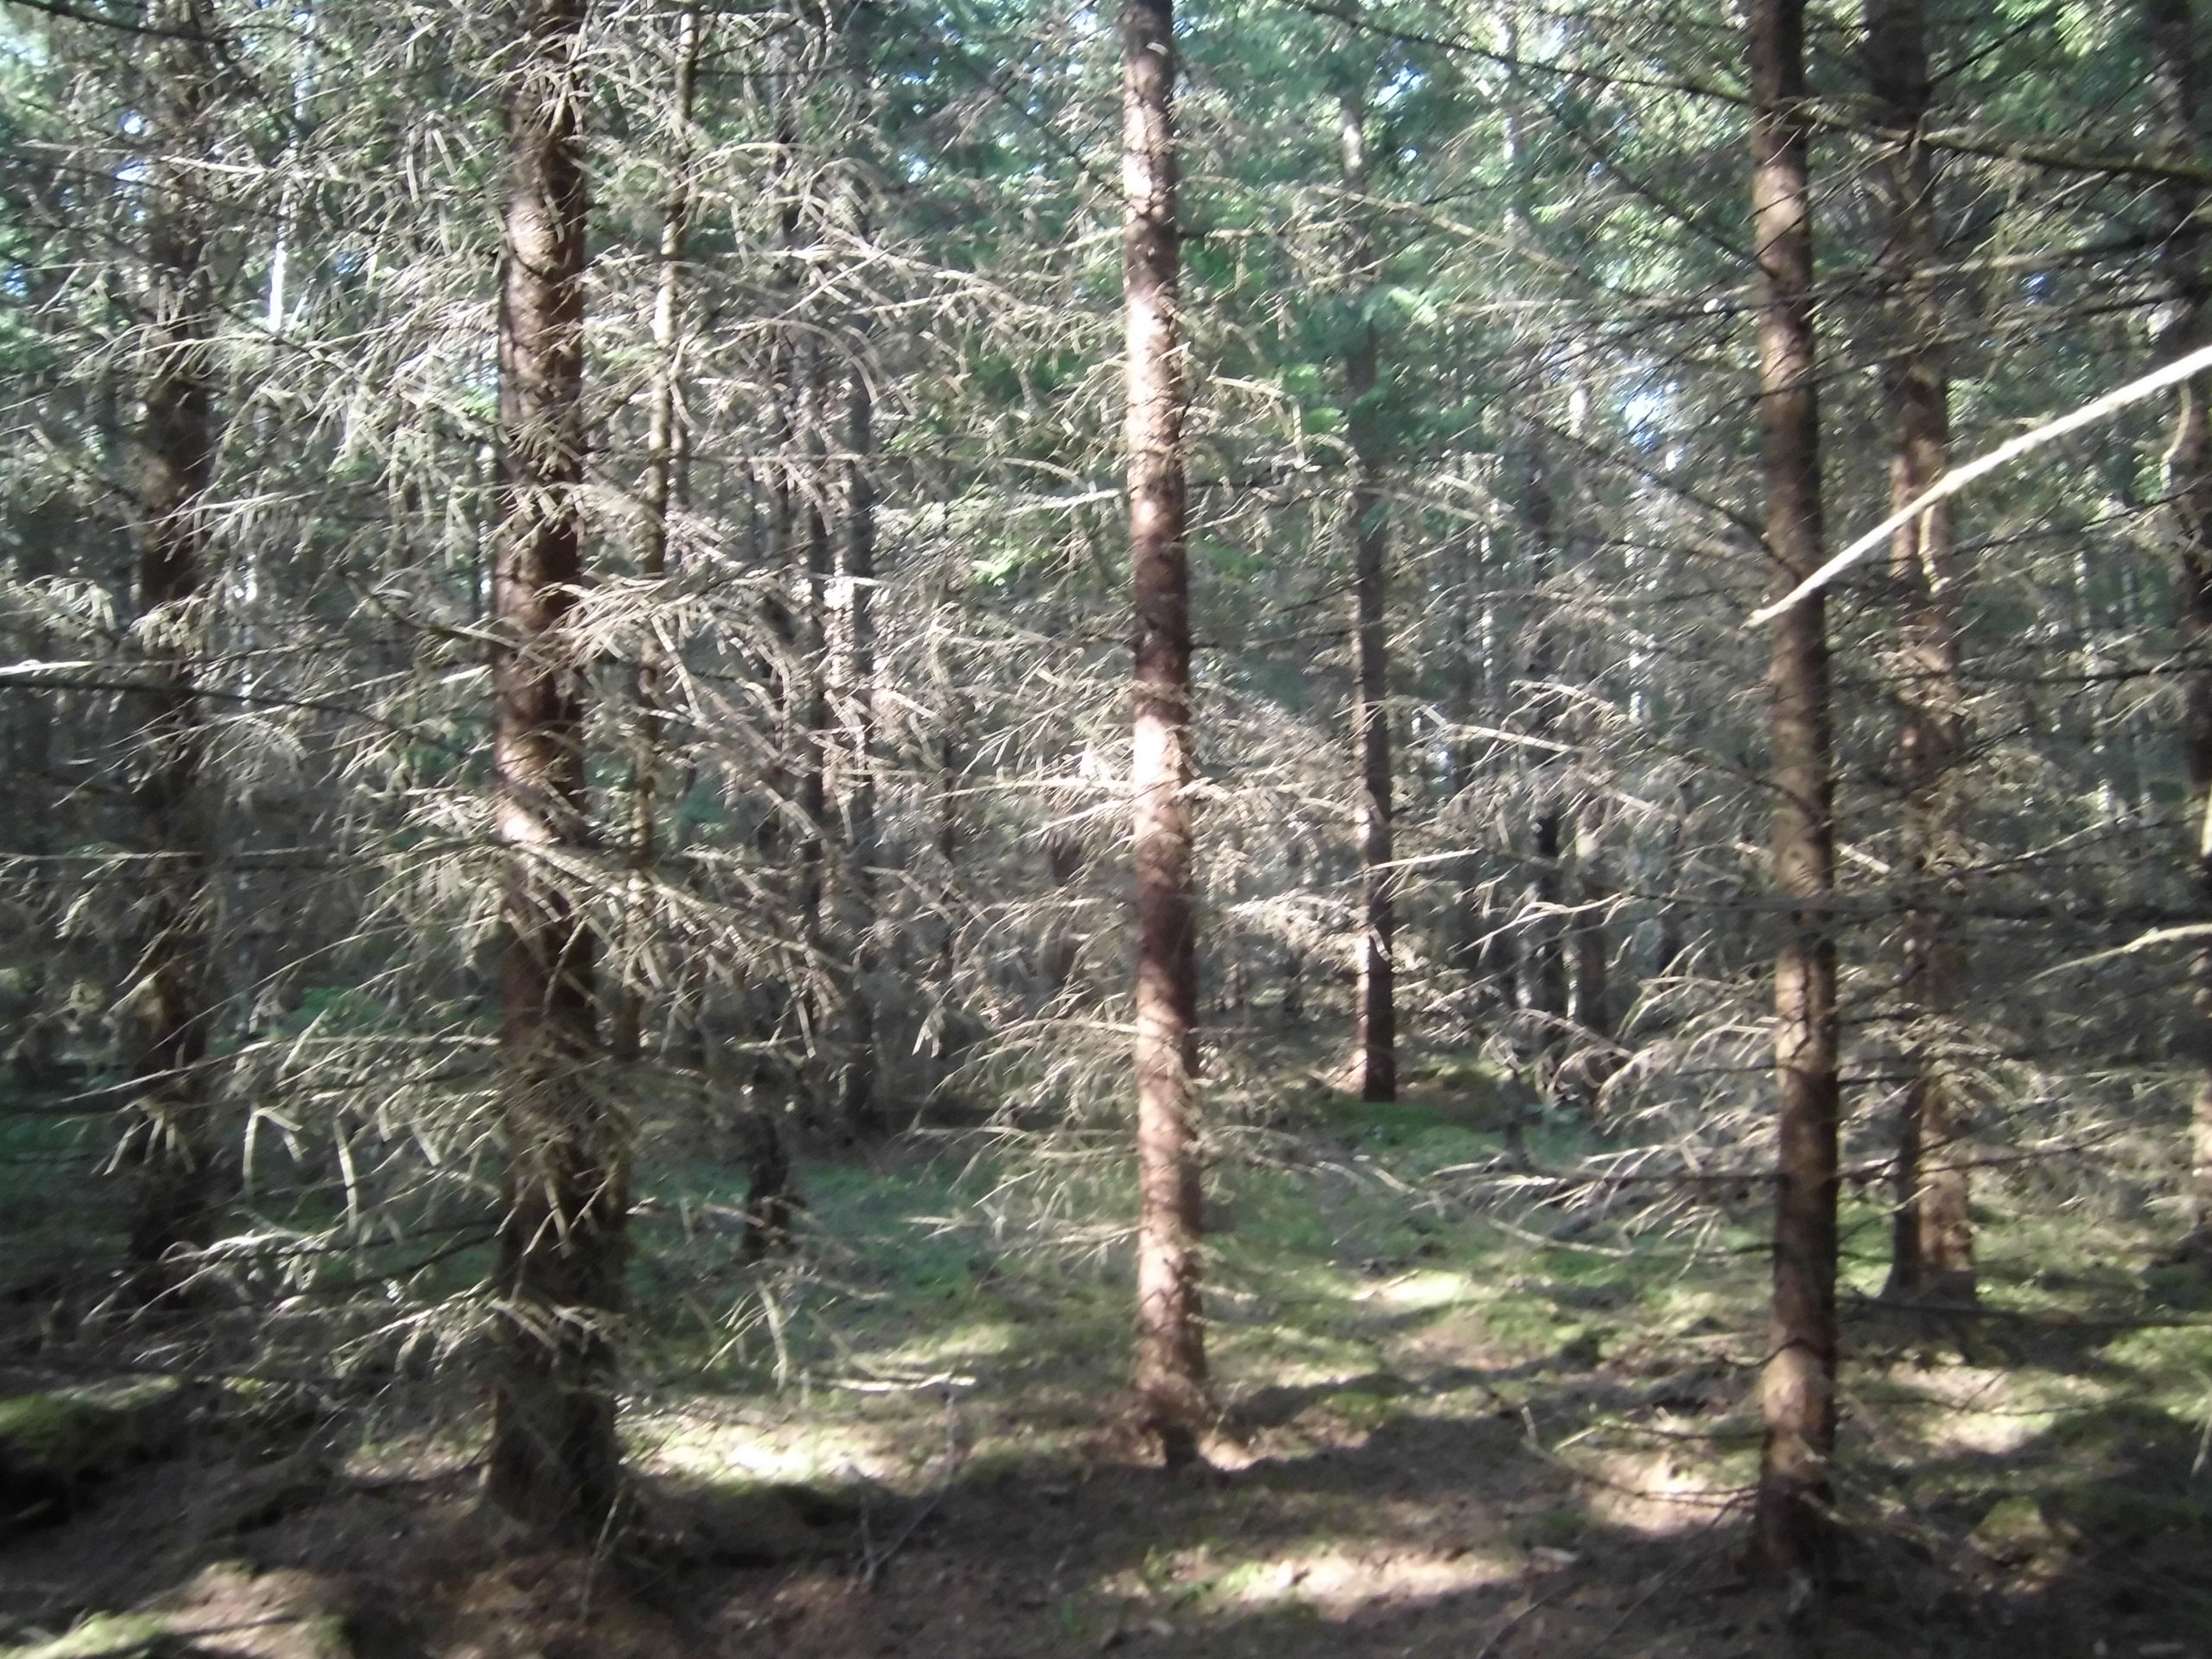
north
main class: Woodland
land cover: Spruce dominated coniferous woodland
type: boreal forest
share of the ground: > 75 %
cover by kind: coniferous forest trees 75 %, unconsolidated bare surface 15 %, herbaceous plants 5 %, lichens and mosses 5 %
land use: Forestry
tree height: > 5 m
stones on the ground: 10 - 25 %
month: July
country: SE
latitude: 57.4170
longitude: 15.1745
